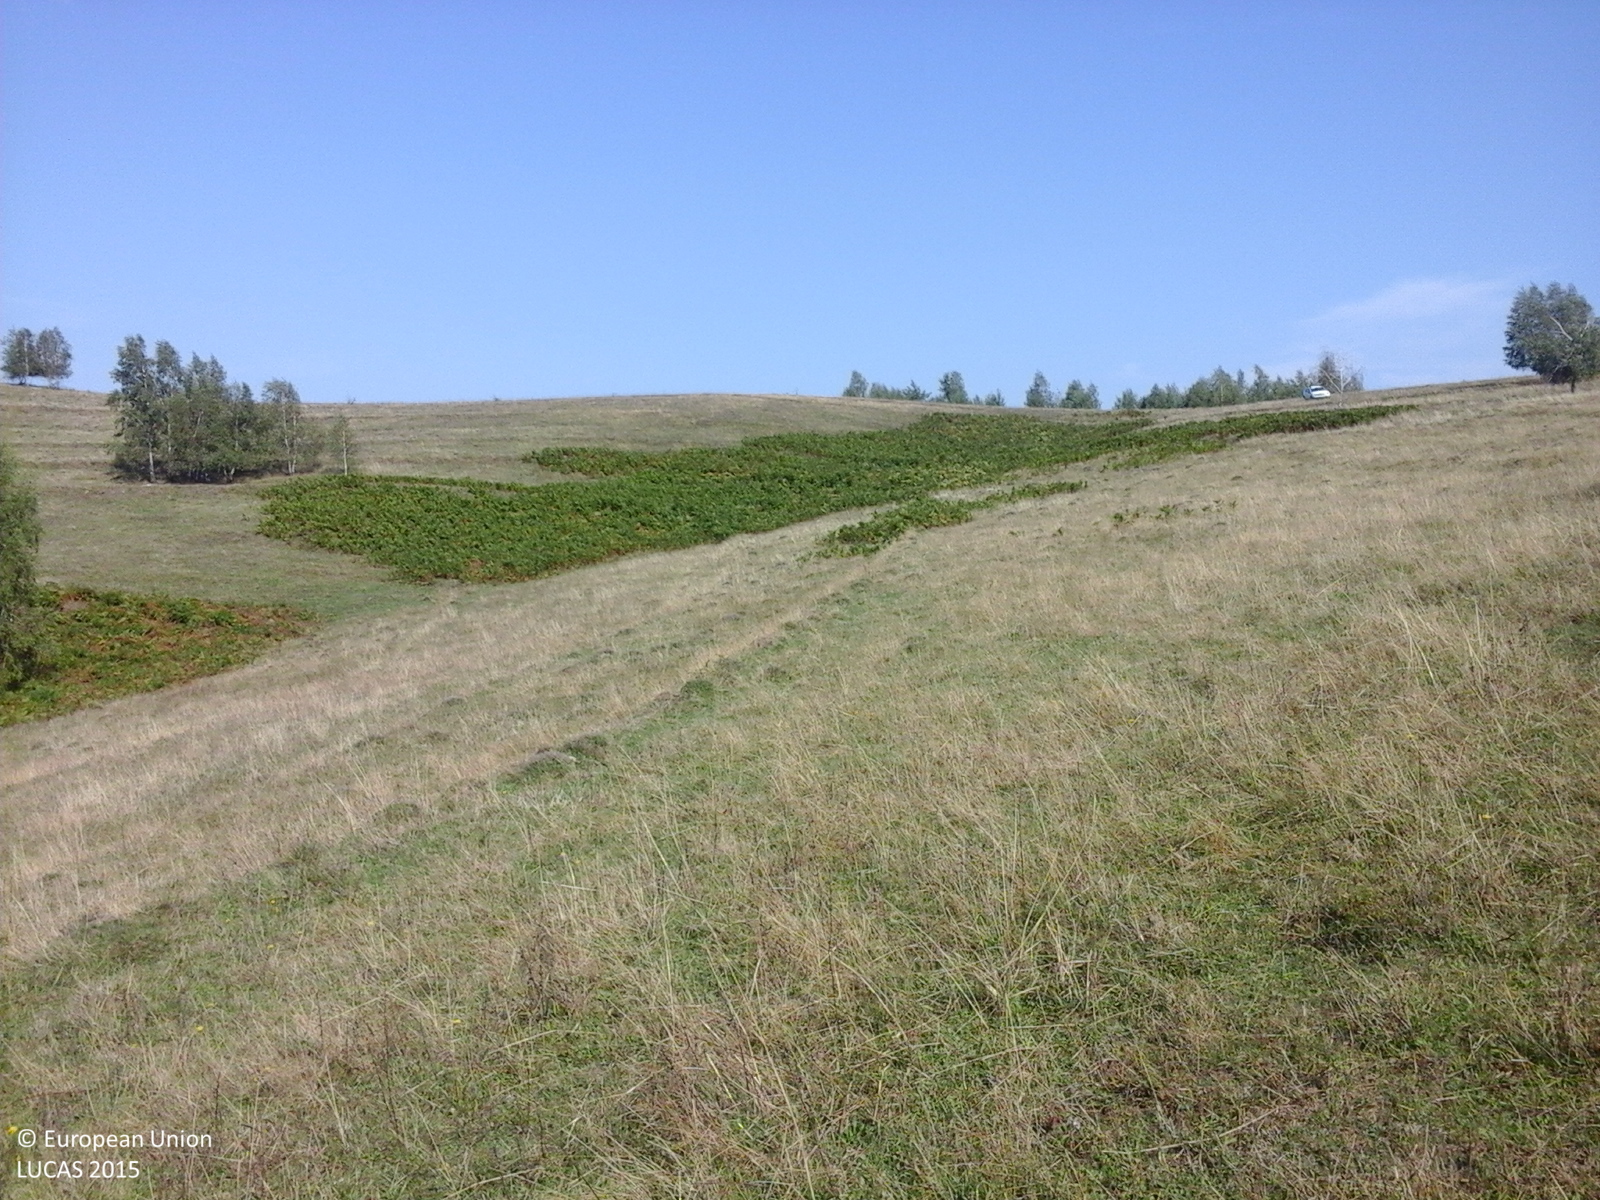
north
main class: Grassland
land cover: Grassland without tree/shrub cover
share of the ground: > 75 %
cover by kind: herbaceous plants 100 %
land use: Agriculture (excluding fallow land and kitchen gardens)
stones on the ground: < 10 %
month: September
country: RO
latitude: 45.8124
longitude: 22.6744
